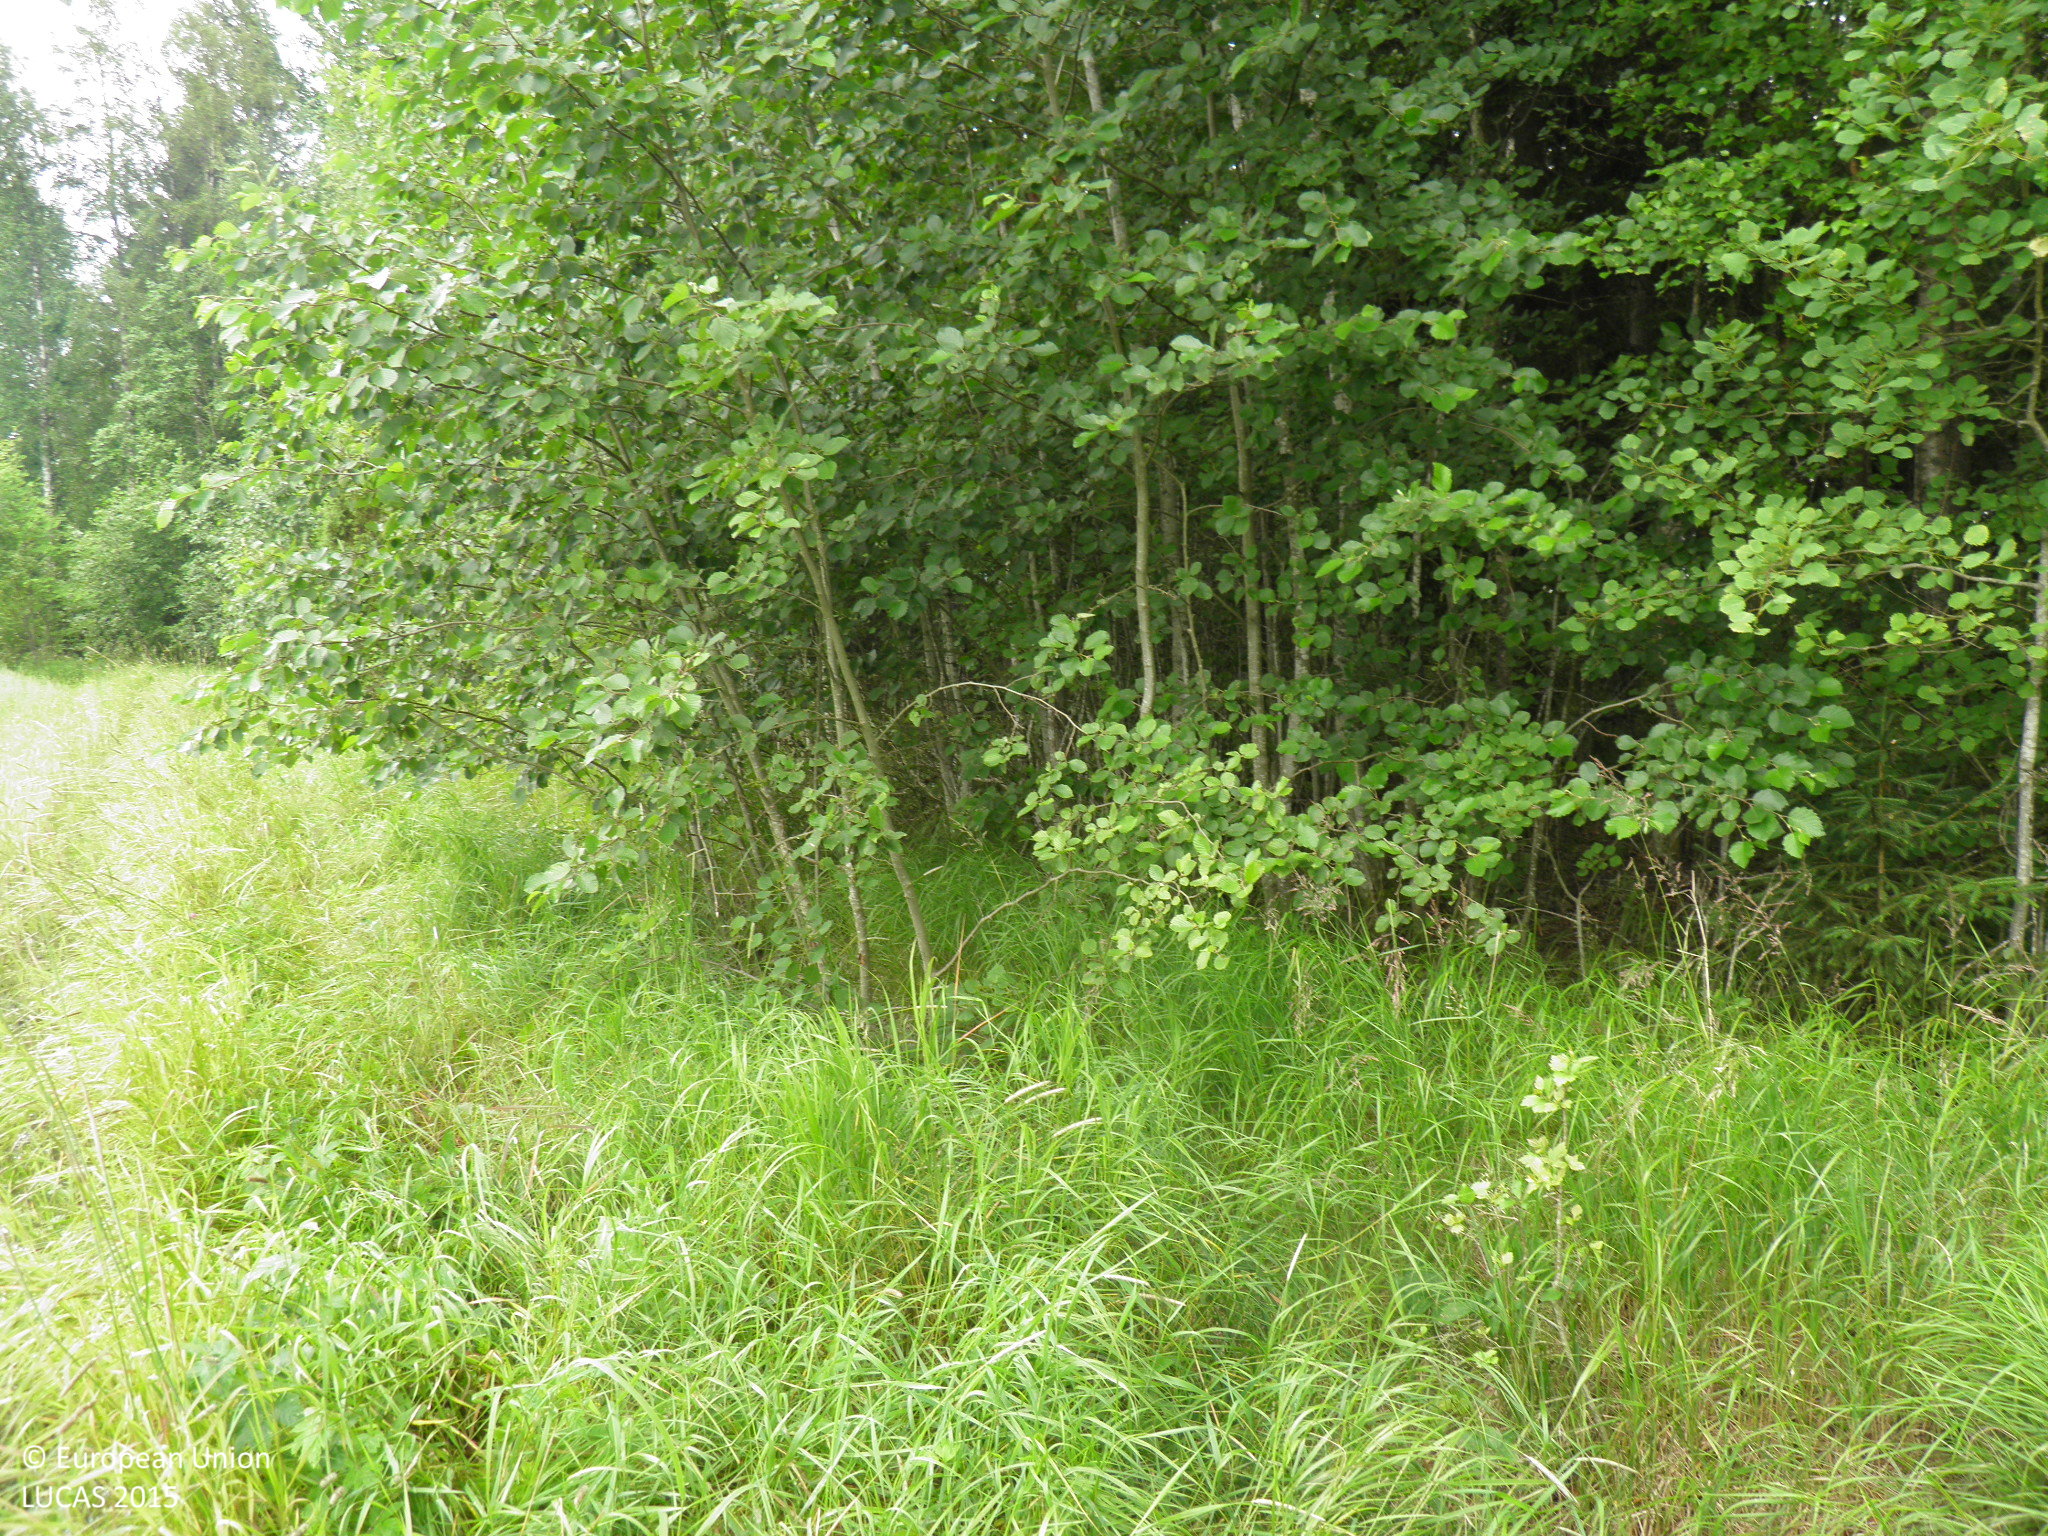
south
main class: Cropland
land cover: Common wheat
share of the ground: > 75 %
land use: Agriculture (excluding fallow land and kitchen gardens)
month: July
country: FI
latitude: 60.8433
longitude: 22.9366
